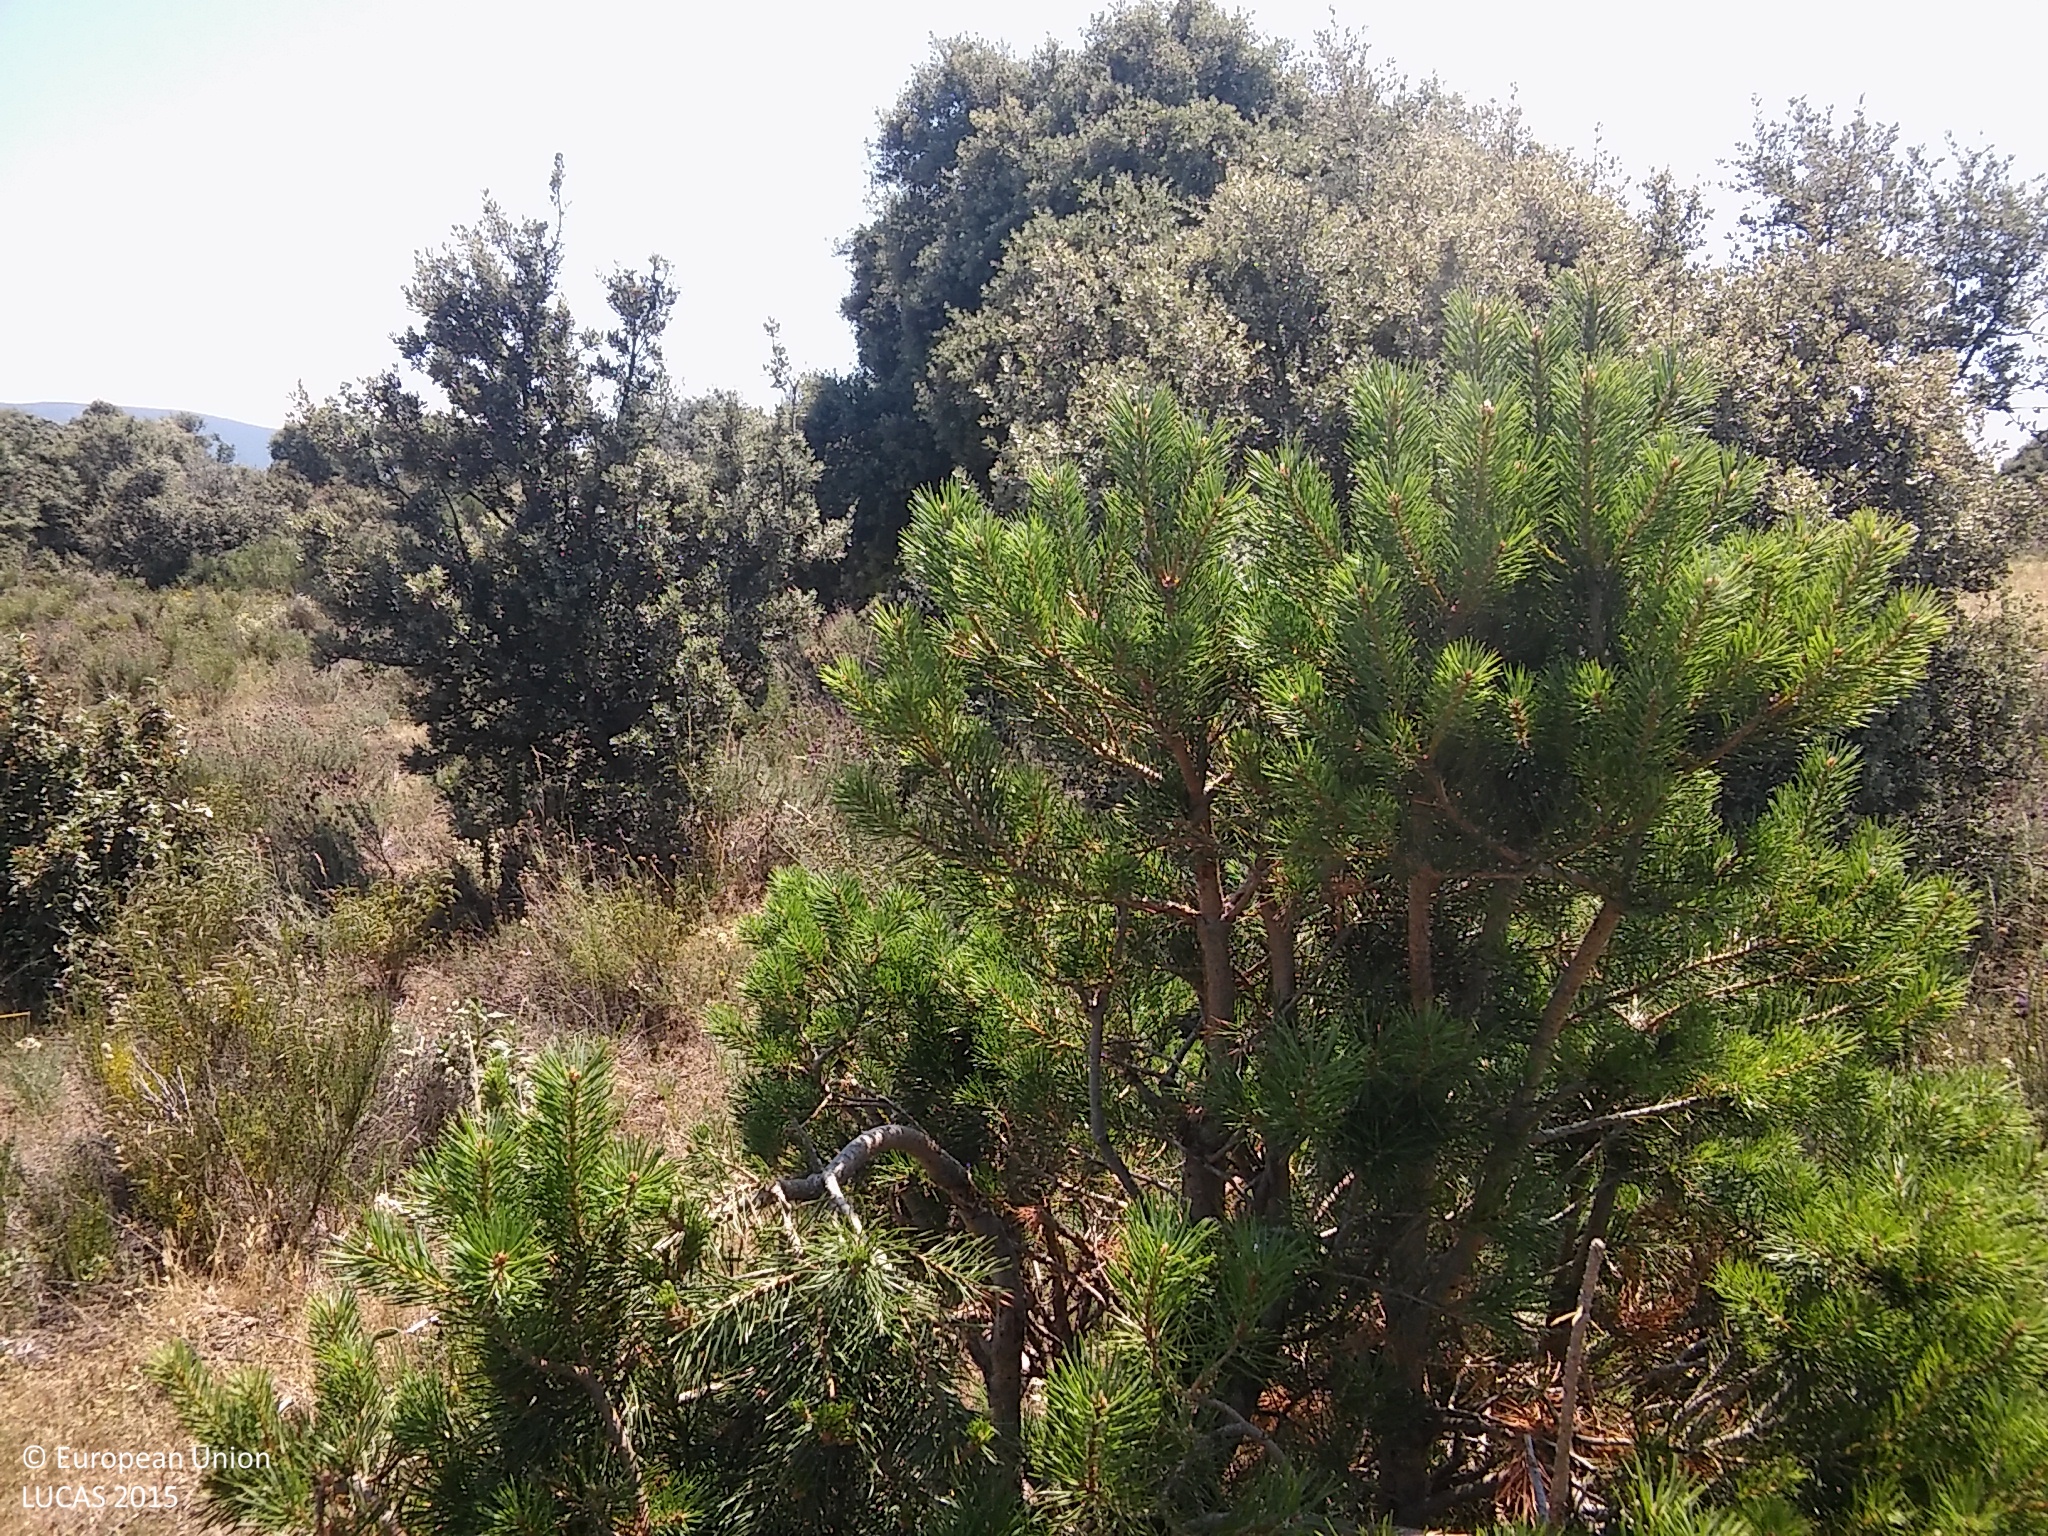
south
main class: Shrubland
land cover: Shrubland with sparse tree cover
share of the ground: 50 - 75 %
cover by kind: shrubs 55 %, herbaceous plants 40 %, coniferous forest trees 5 %
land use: Agriculture (excluding fallow land and kitchen gardens)
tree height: < 5 m
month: June
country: ES
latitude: 41.1050
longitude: -3.8973
